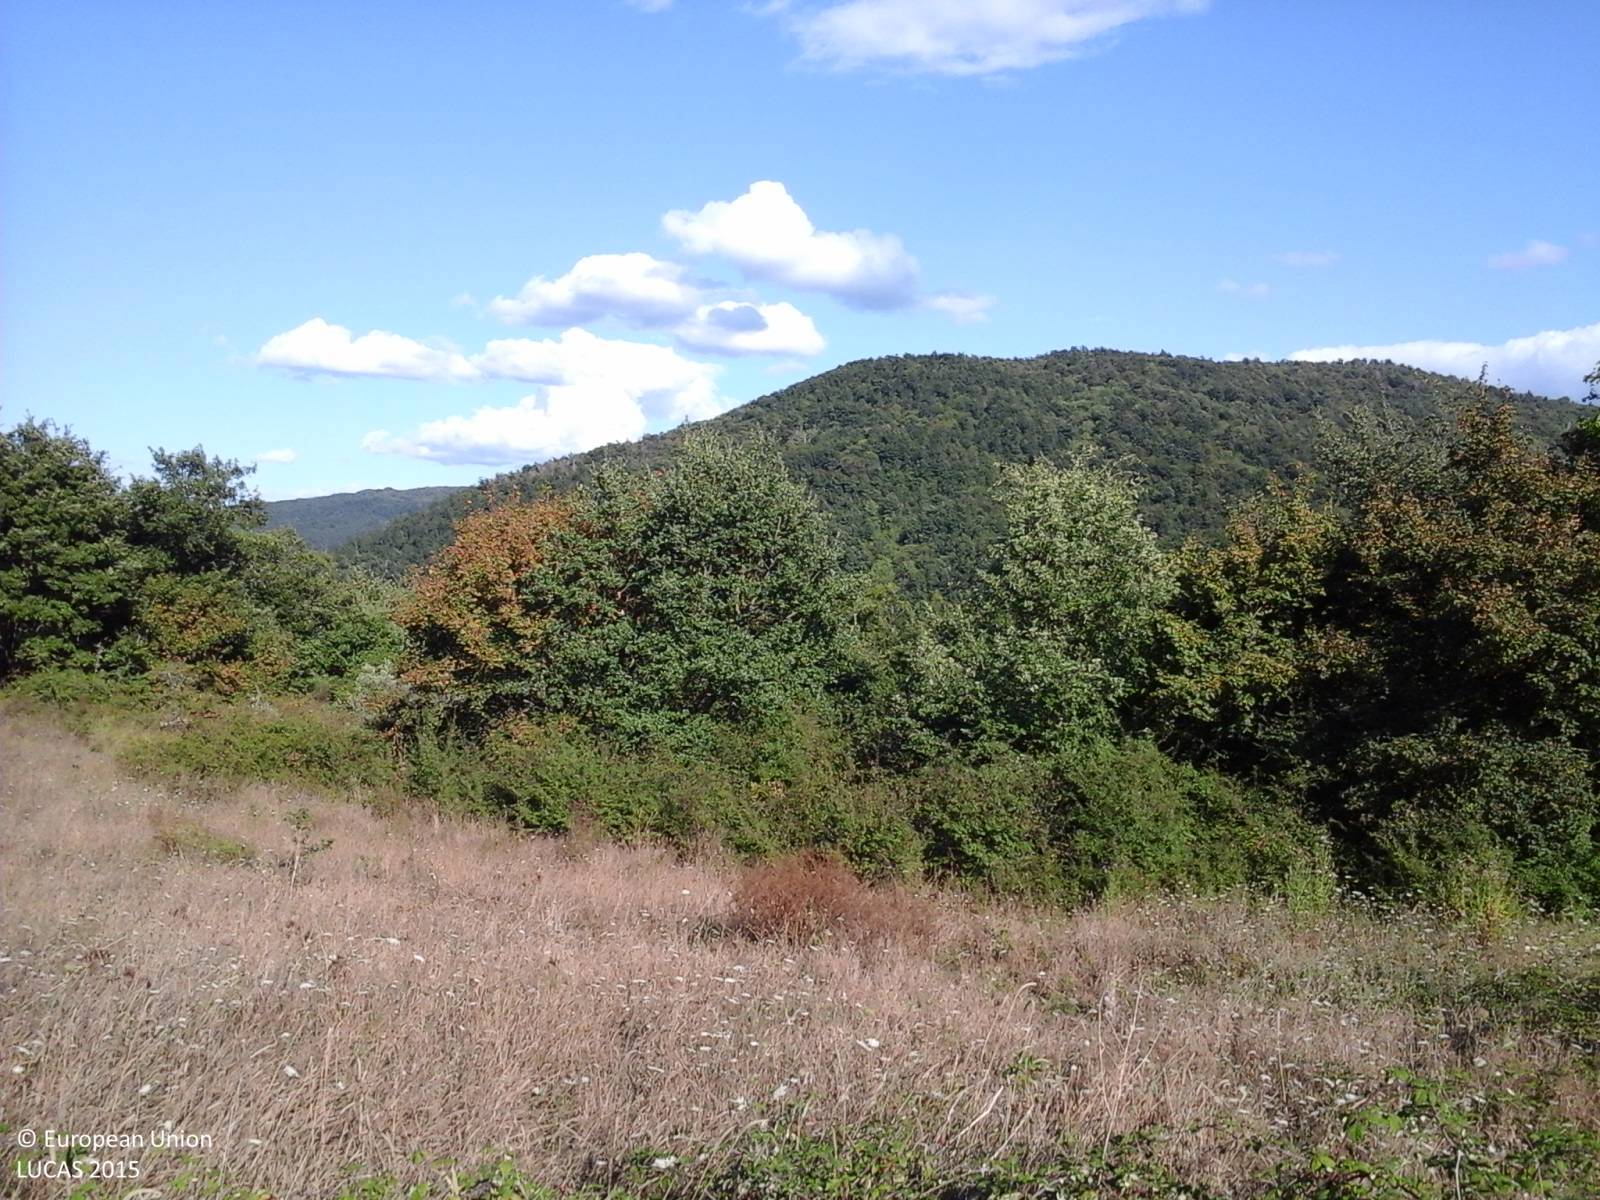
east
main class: Grassland
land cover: Grassland without tree/shrub cover
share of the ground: > 75 %
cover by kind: herbaceous plants 100 %
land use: Agriculture (excluding fallow land and kitchen gardens)
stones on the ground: < 10 %
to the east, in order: Grassland without tree/shrub cover; Abandoned hedges; Grassland without tree/shrub cover; Broadleaved woodland
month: August
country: IT
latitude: 43.3005
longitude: 12.1020
